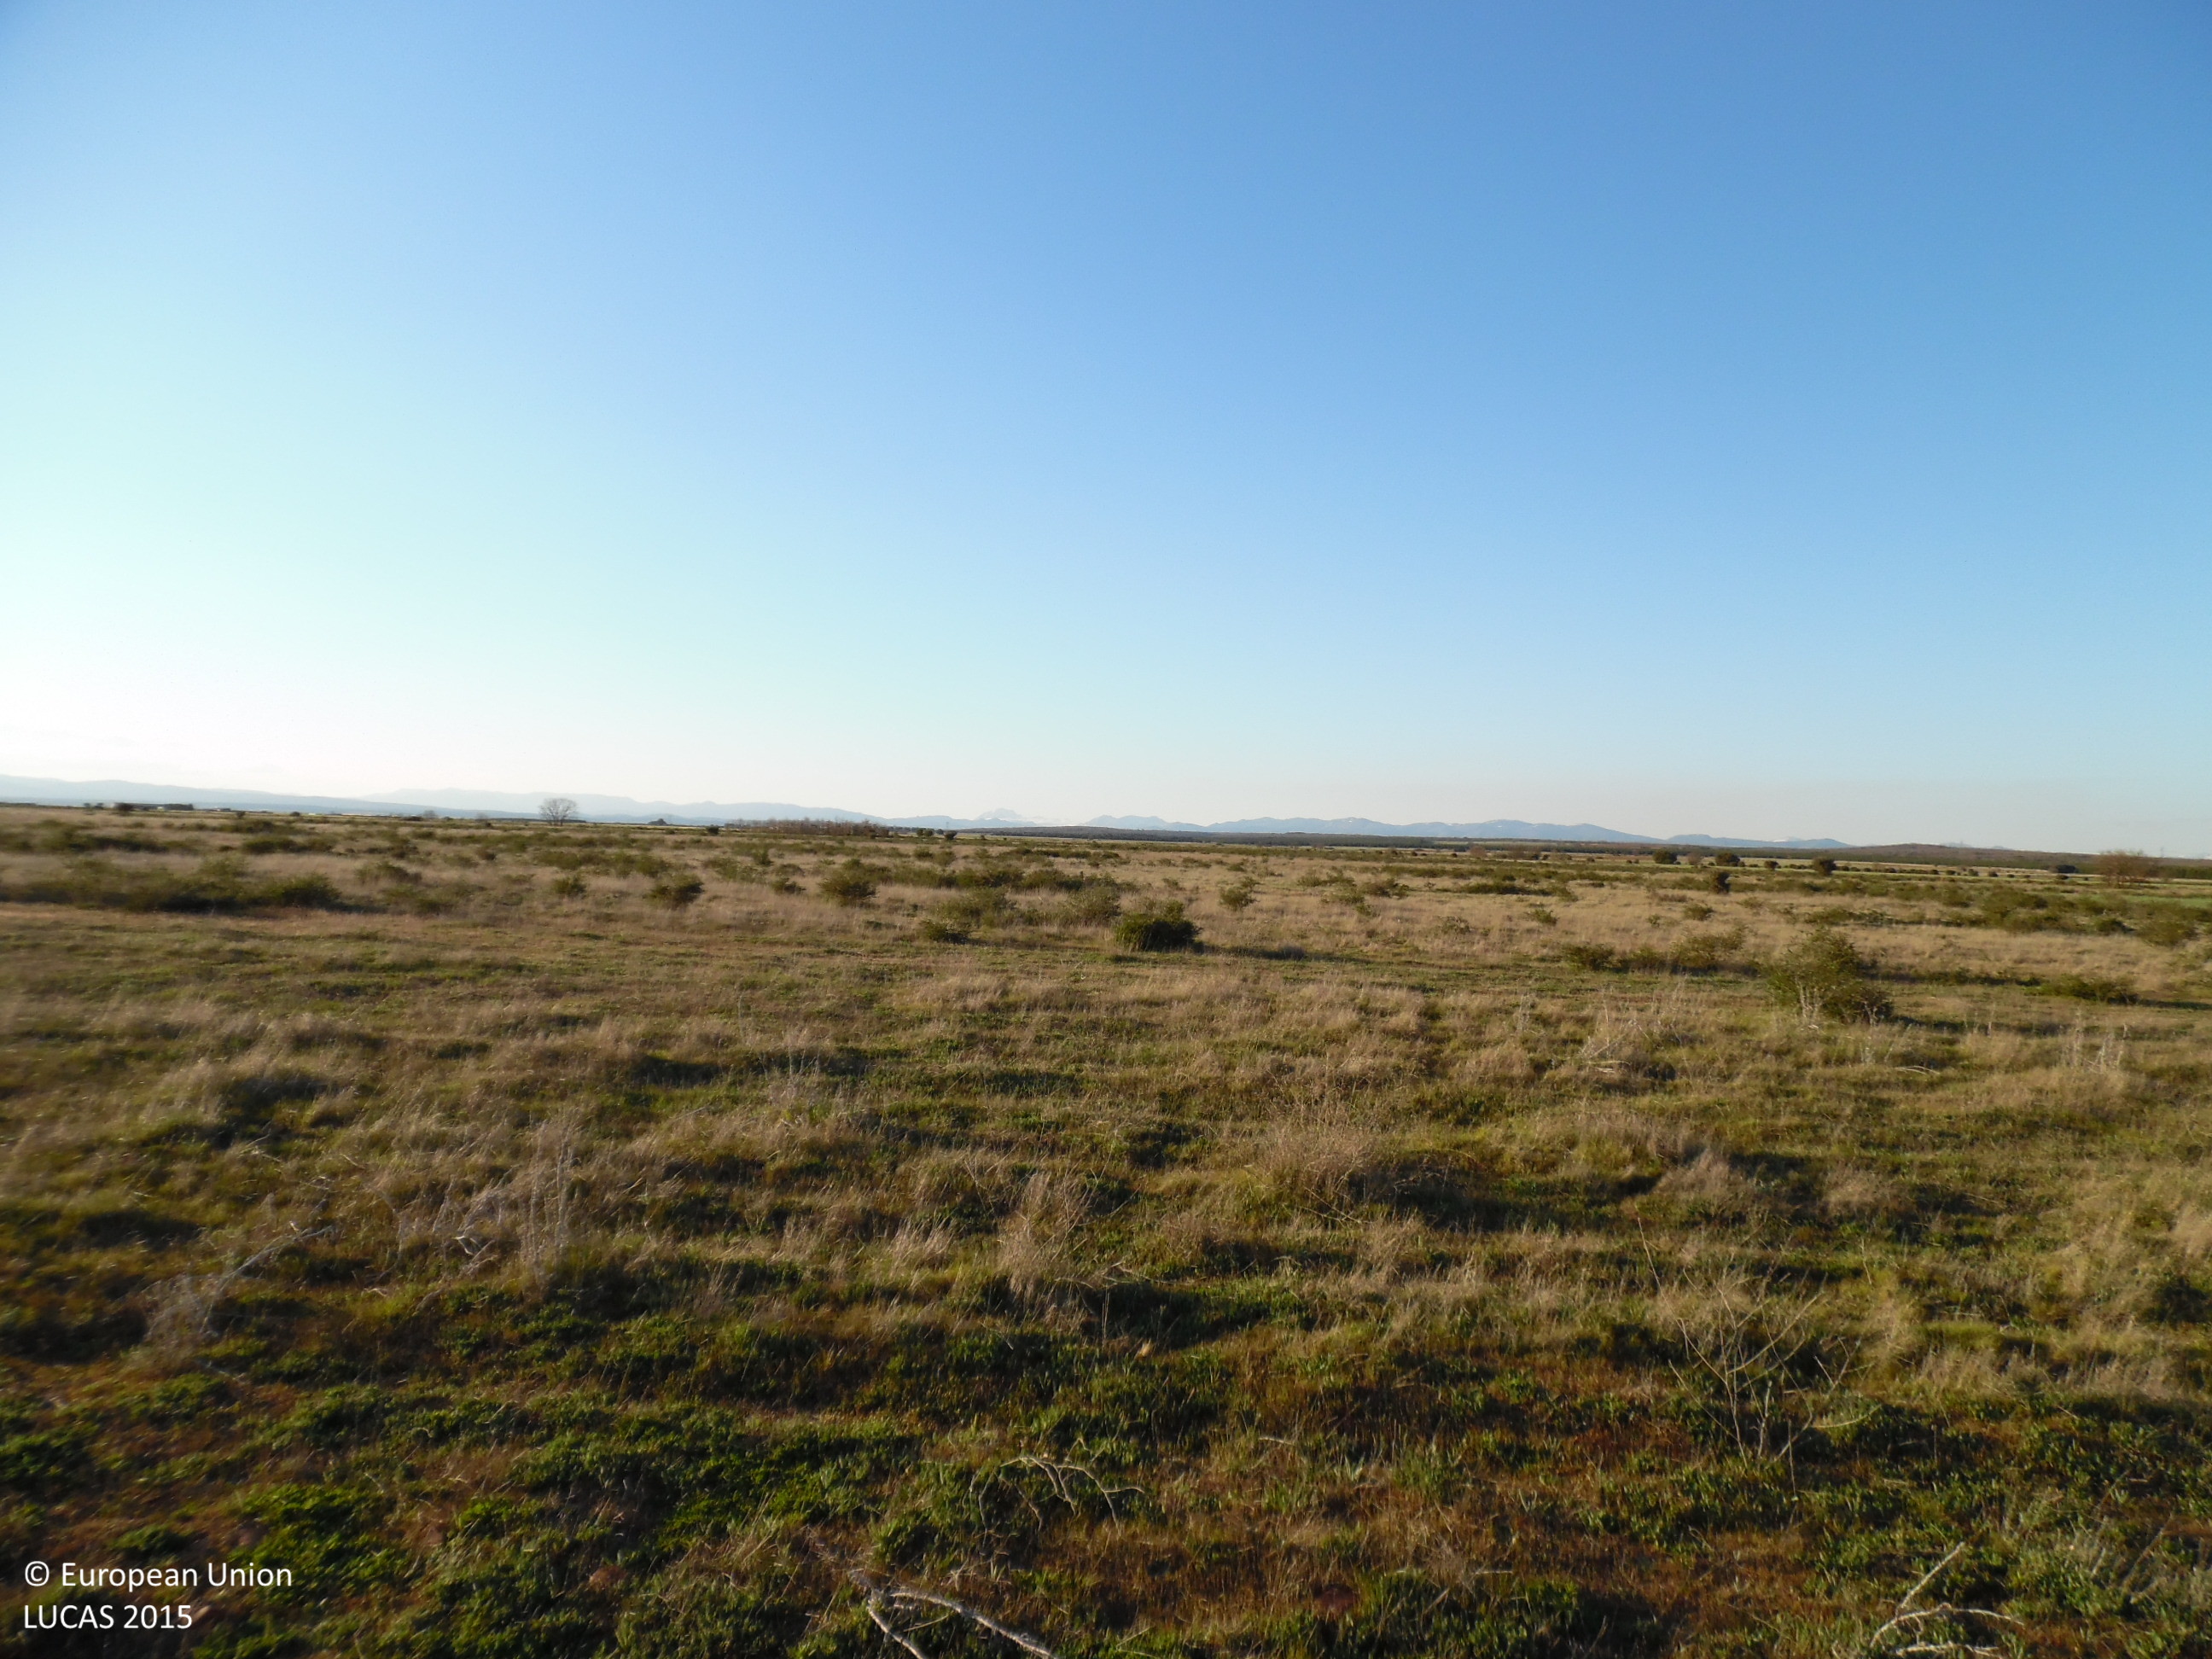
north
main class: Grassland
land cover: Spontaneously vegetated surfaces
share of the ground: > 75 %
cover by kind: herbaceous plants 95 %, shrubs 5 %
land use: Fallow land
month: April
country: ES
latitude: 42.5476
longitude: -5.7736
